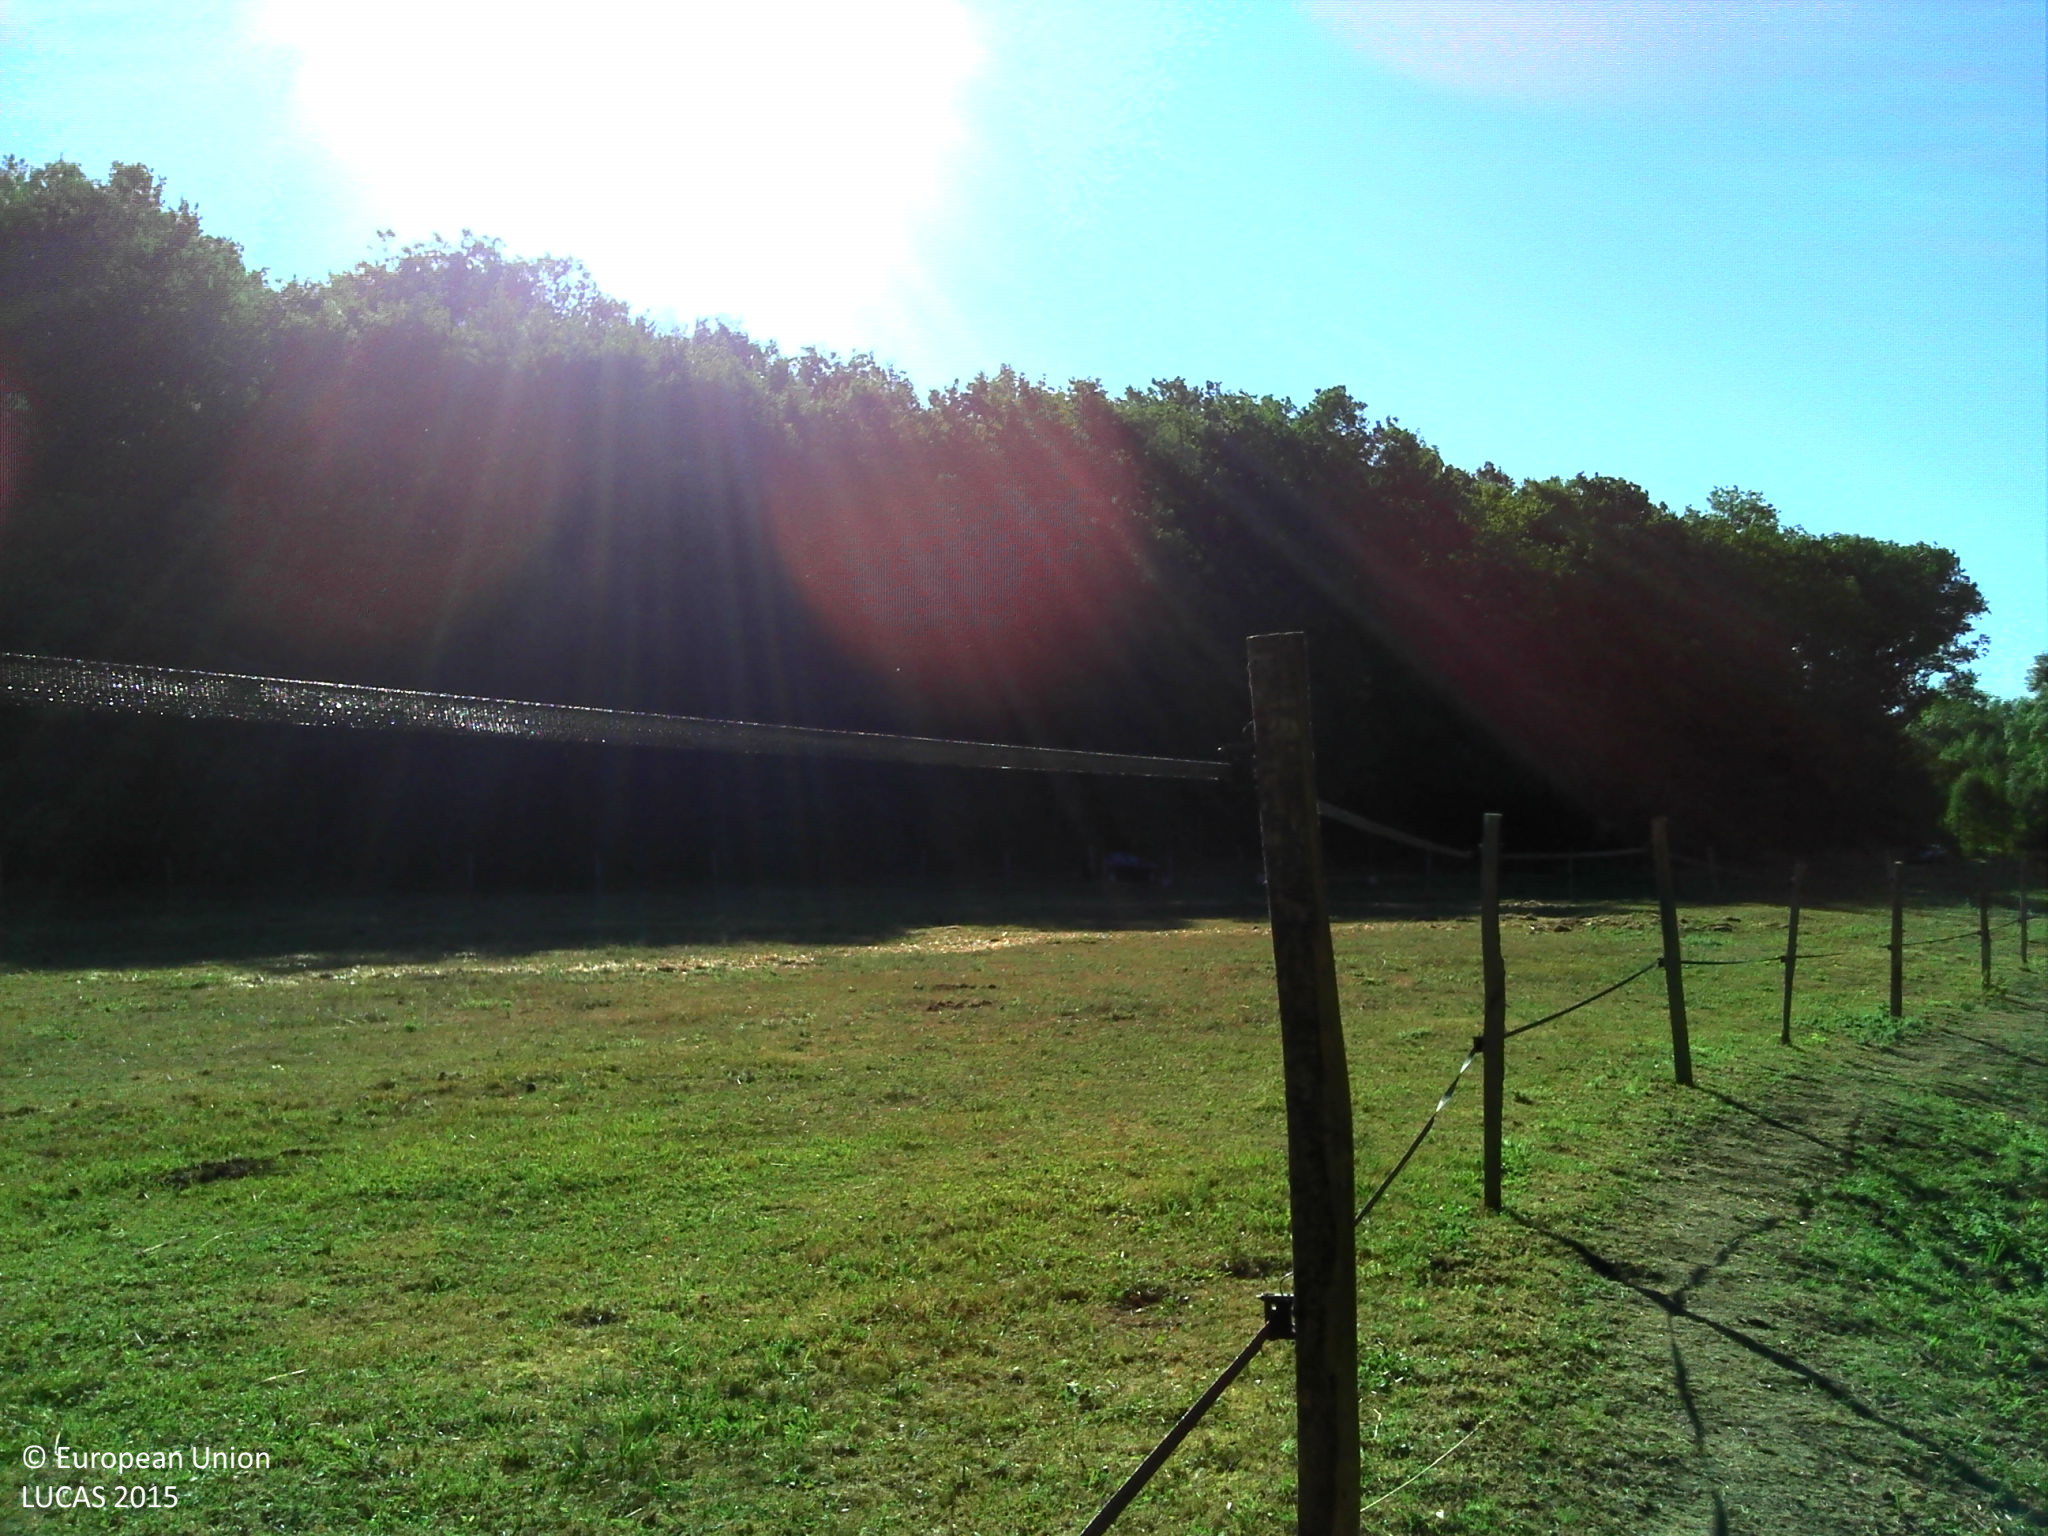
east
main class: Grassland
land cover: Grassland without tree/shrub cover
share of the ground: > 75 %
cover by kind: herbaceous plants 90 %, lichens and mosses 10 %
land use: Agriculture (excluding fallow land and kitchen gardens)
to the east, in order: Grassland without tree/shrub cover; Fences; Grassland without tree/shrub cover; Fences; Paved roads, cycling and walking lanes; Grass margins; Electric lines; Broadleaved woodland
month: July
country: FR
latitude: 44.7559
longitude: 0.5803
